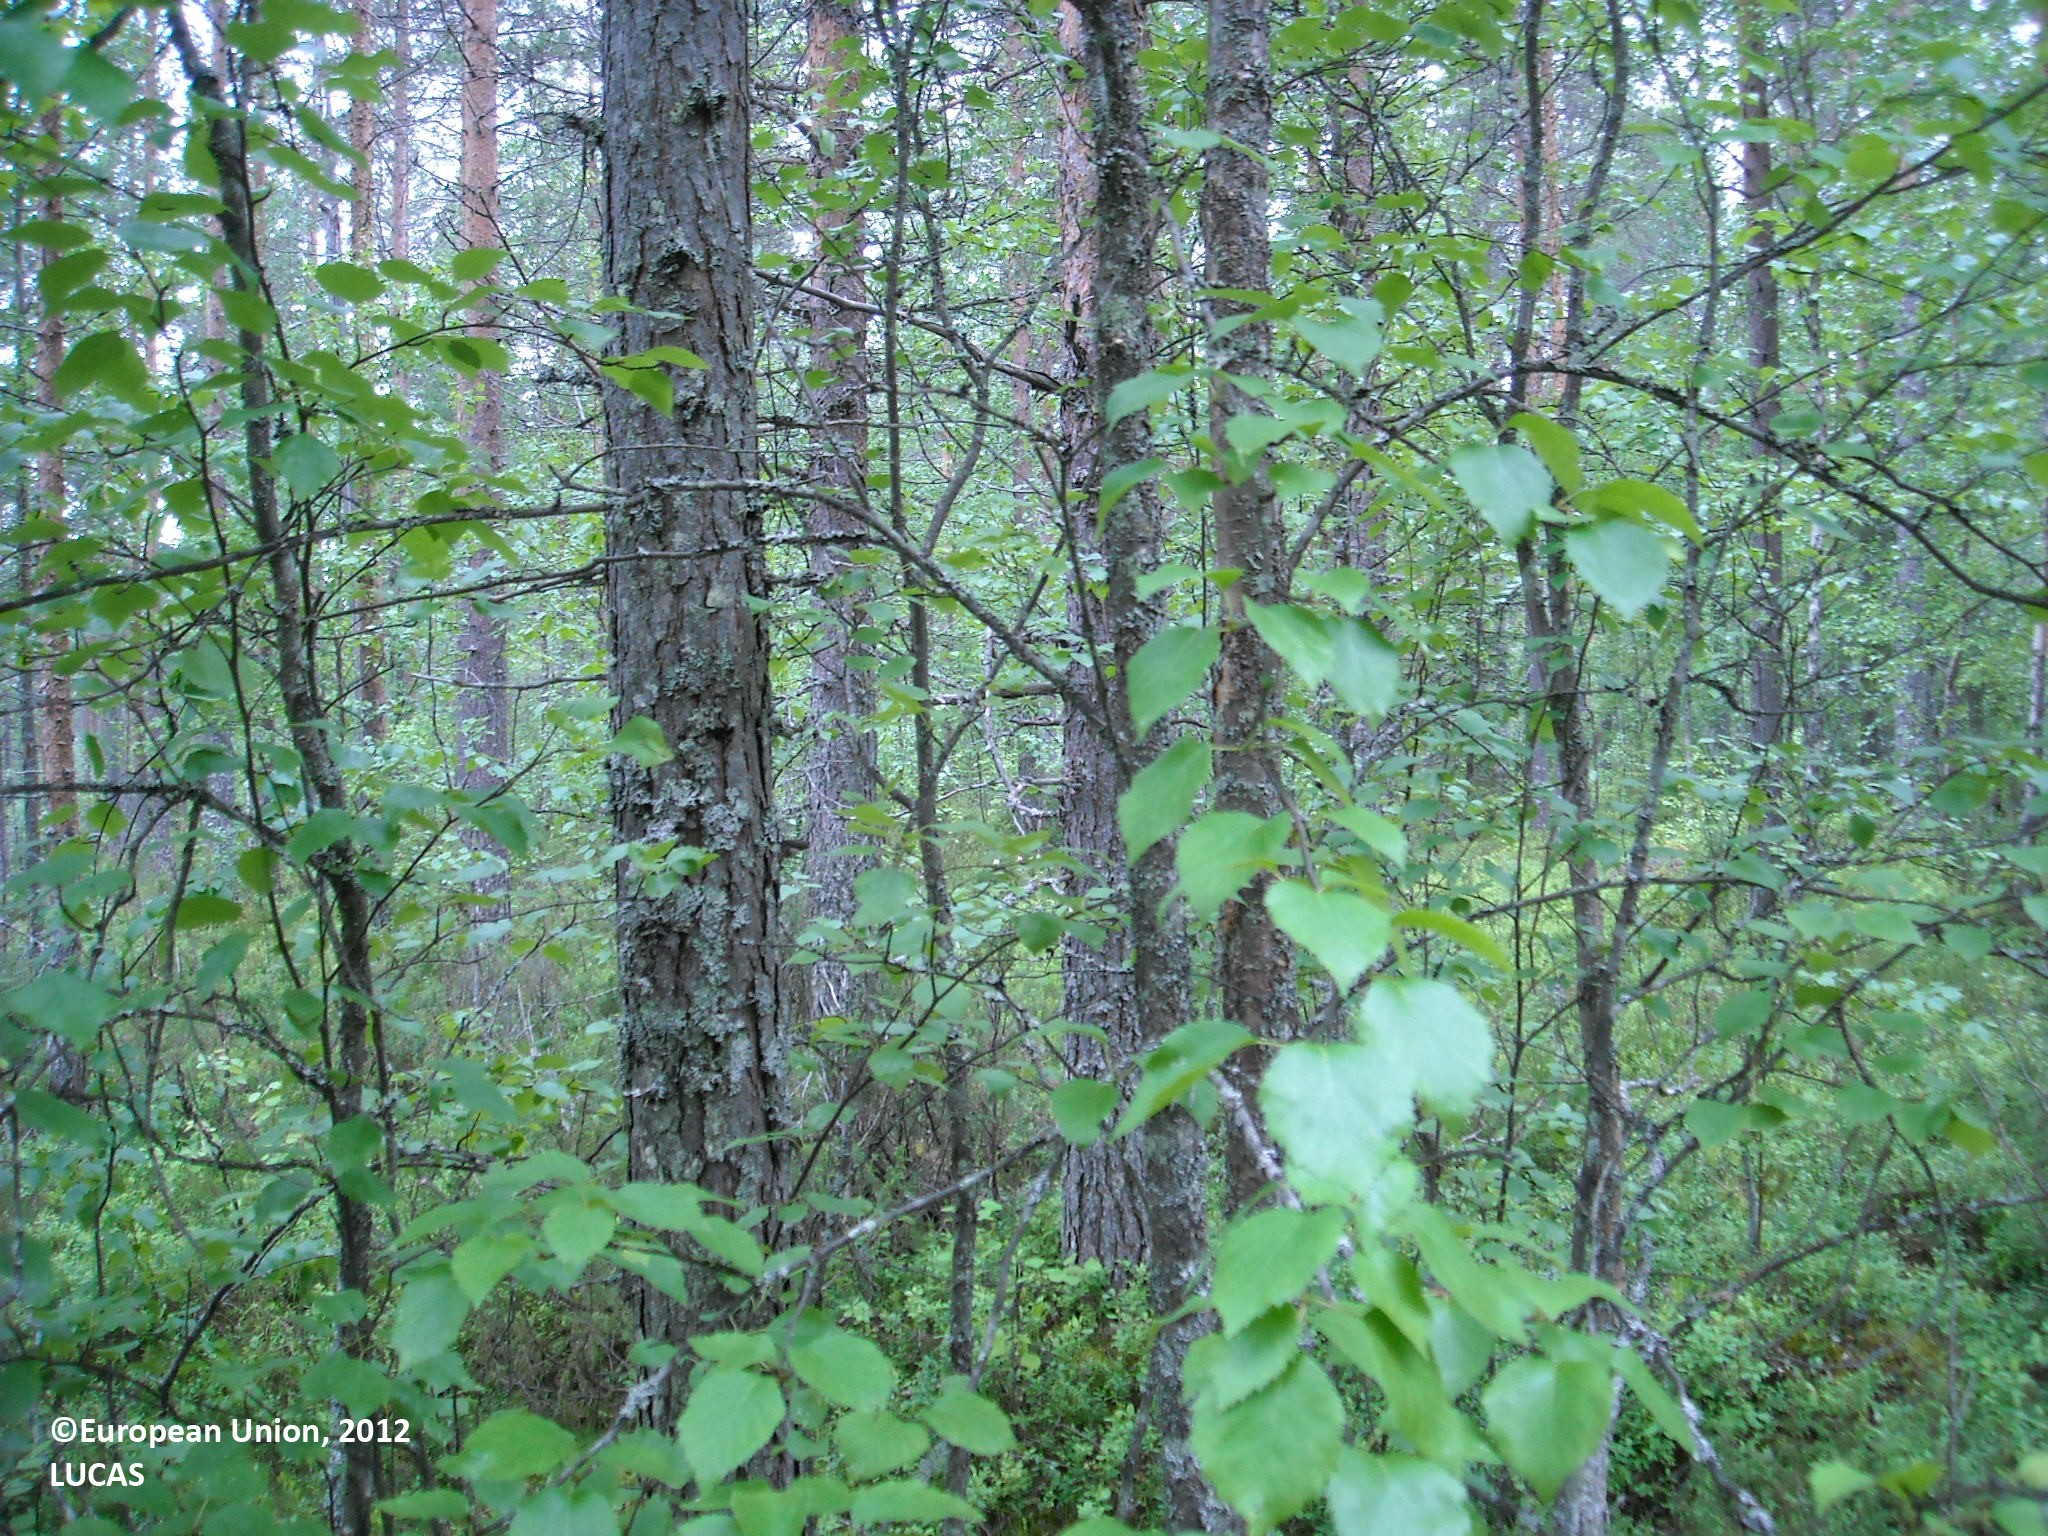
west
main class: Woodland
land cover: Pine dominated mixed woodland
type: boreal forest
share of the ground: > 75 %
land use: Forestry
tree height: > 5 m
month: June
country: FI
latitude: 64.8087
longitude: 27.3370
